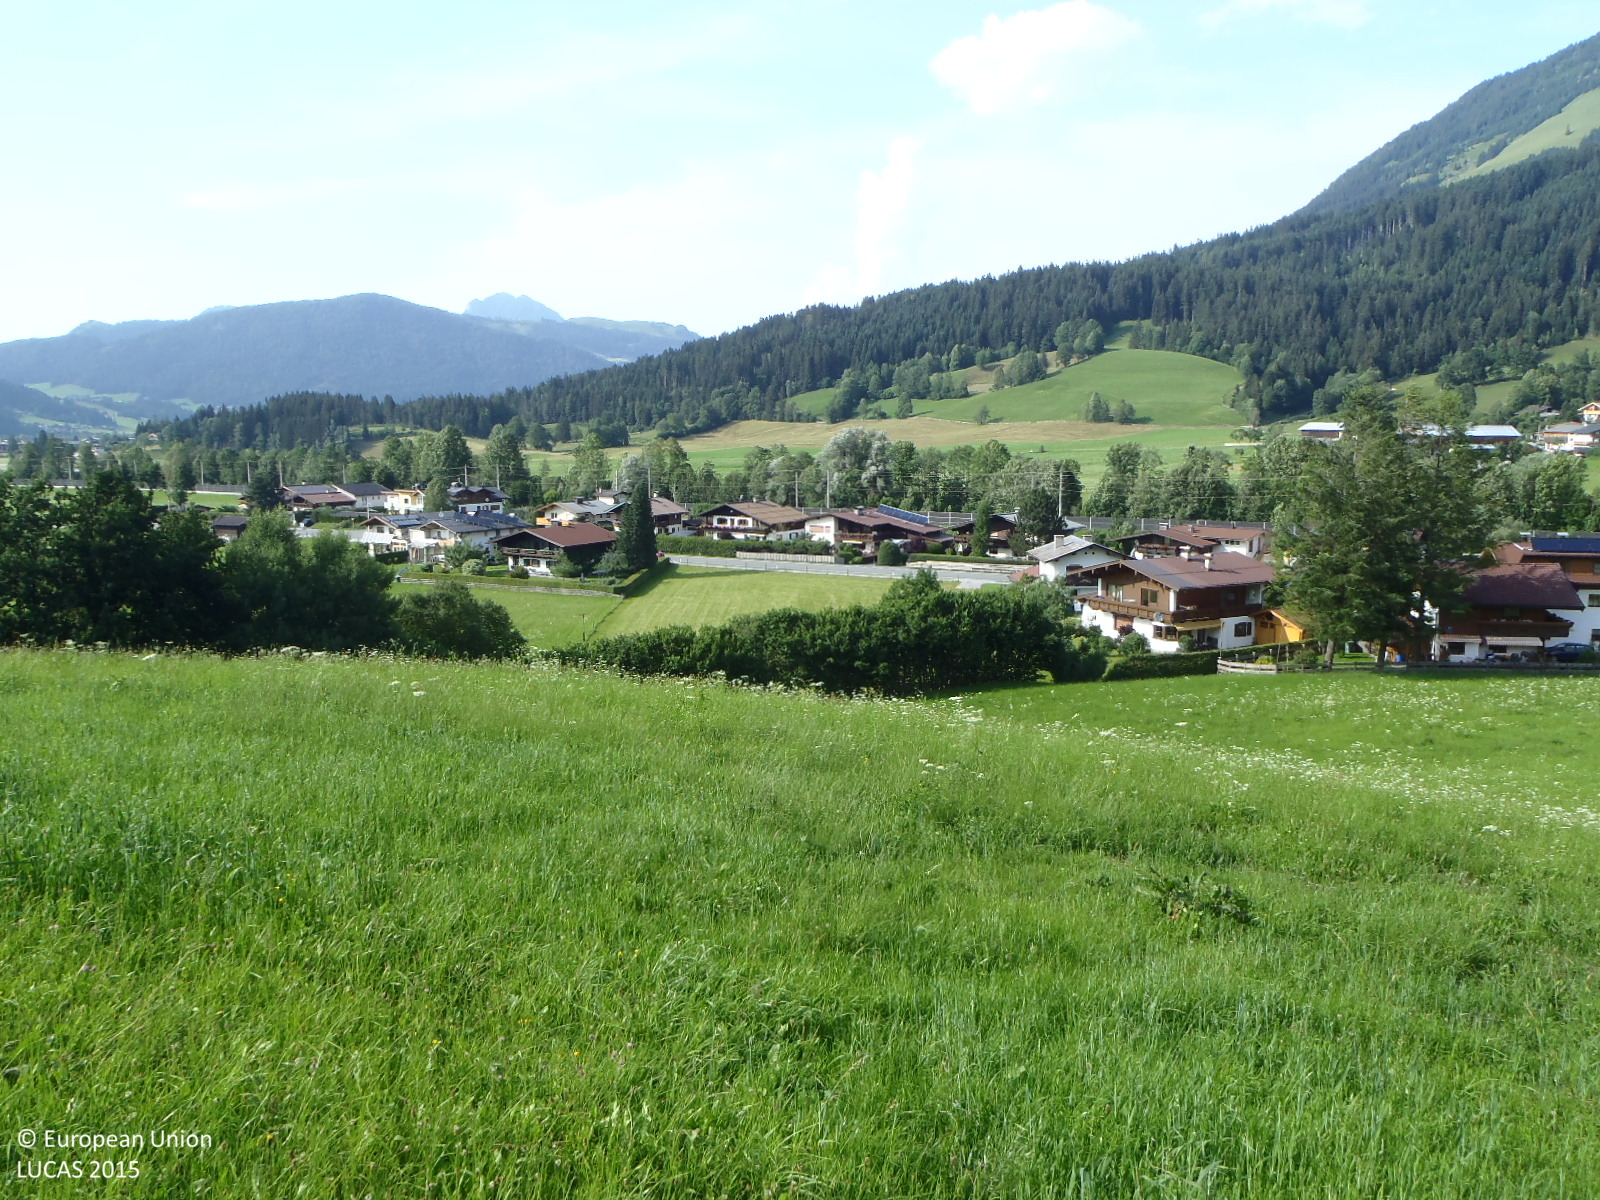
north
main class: Grassland
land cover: Grassland without tree/shrub cover
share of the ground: > 75 %
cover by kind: herbaceous plants 100 %
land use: Agriculture (excluding fallow land and kitchen gardens)
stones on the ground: < 10 %
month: July
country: AT
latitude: 47.5120
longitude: 12.4548
